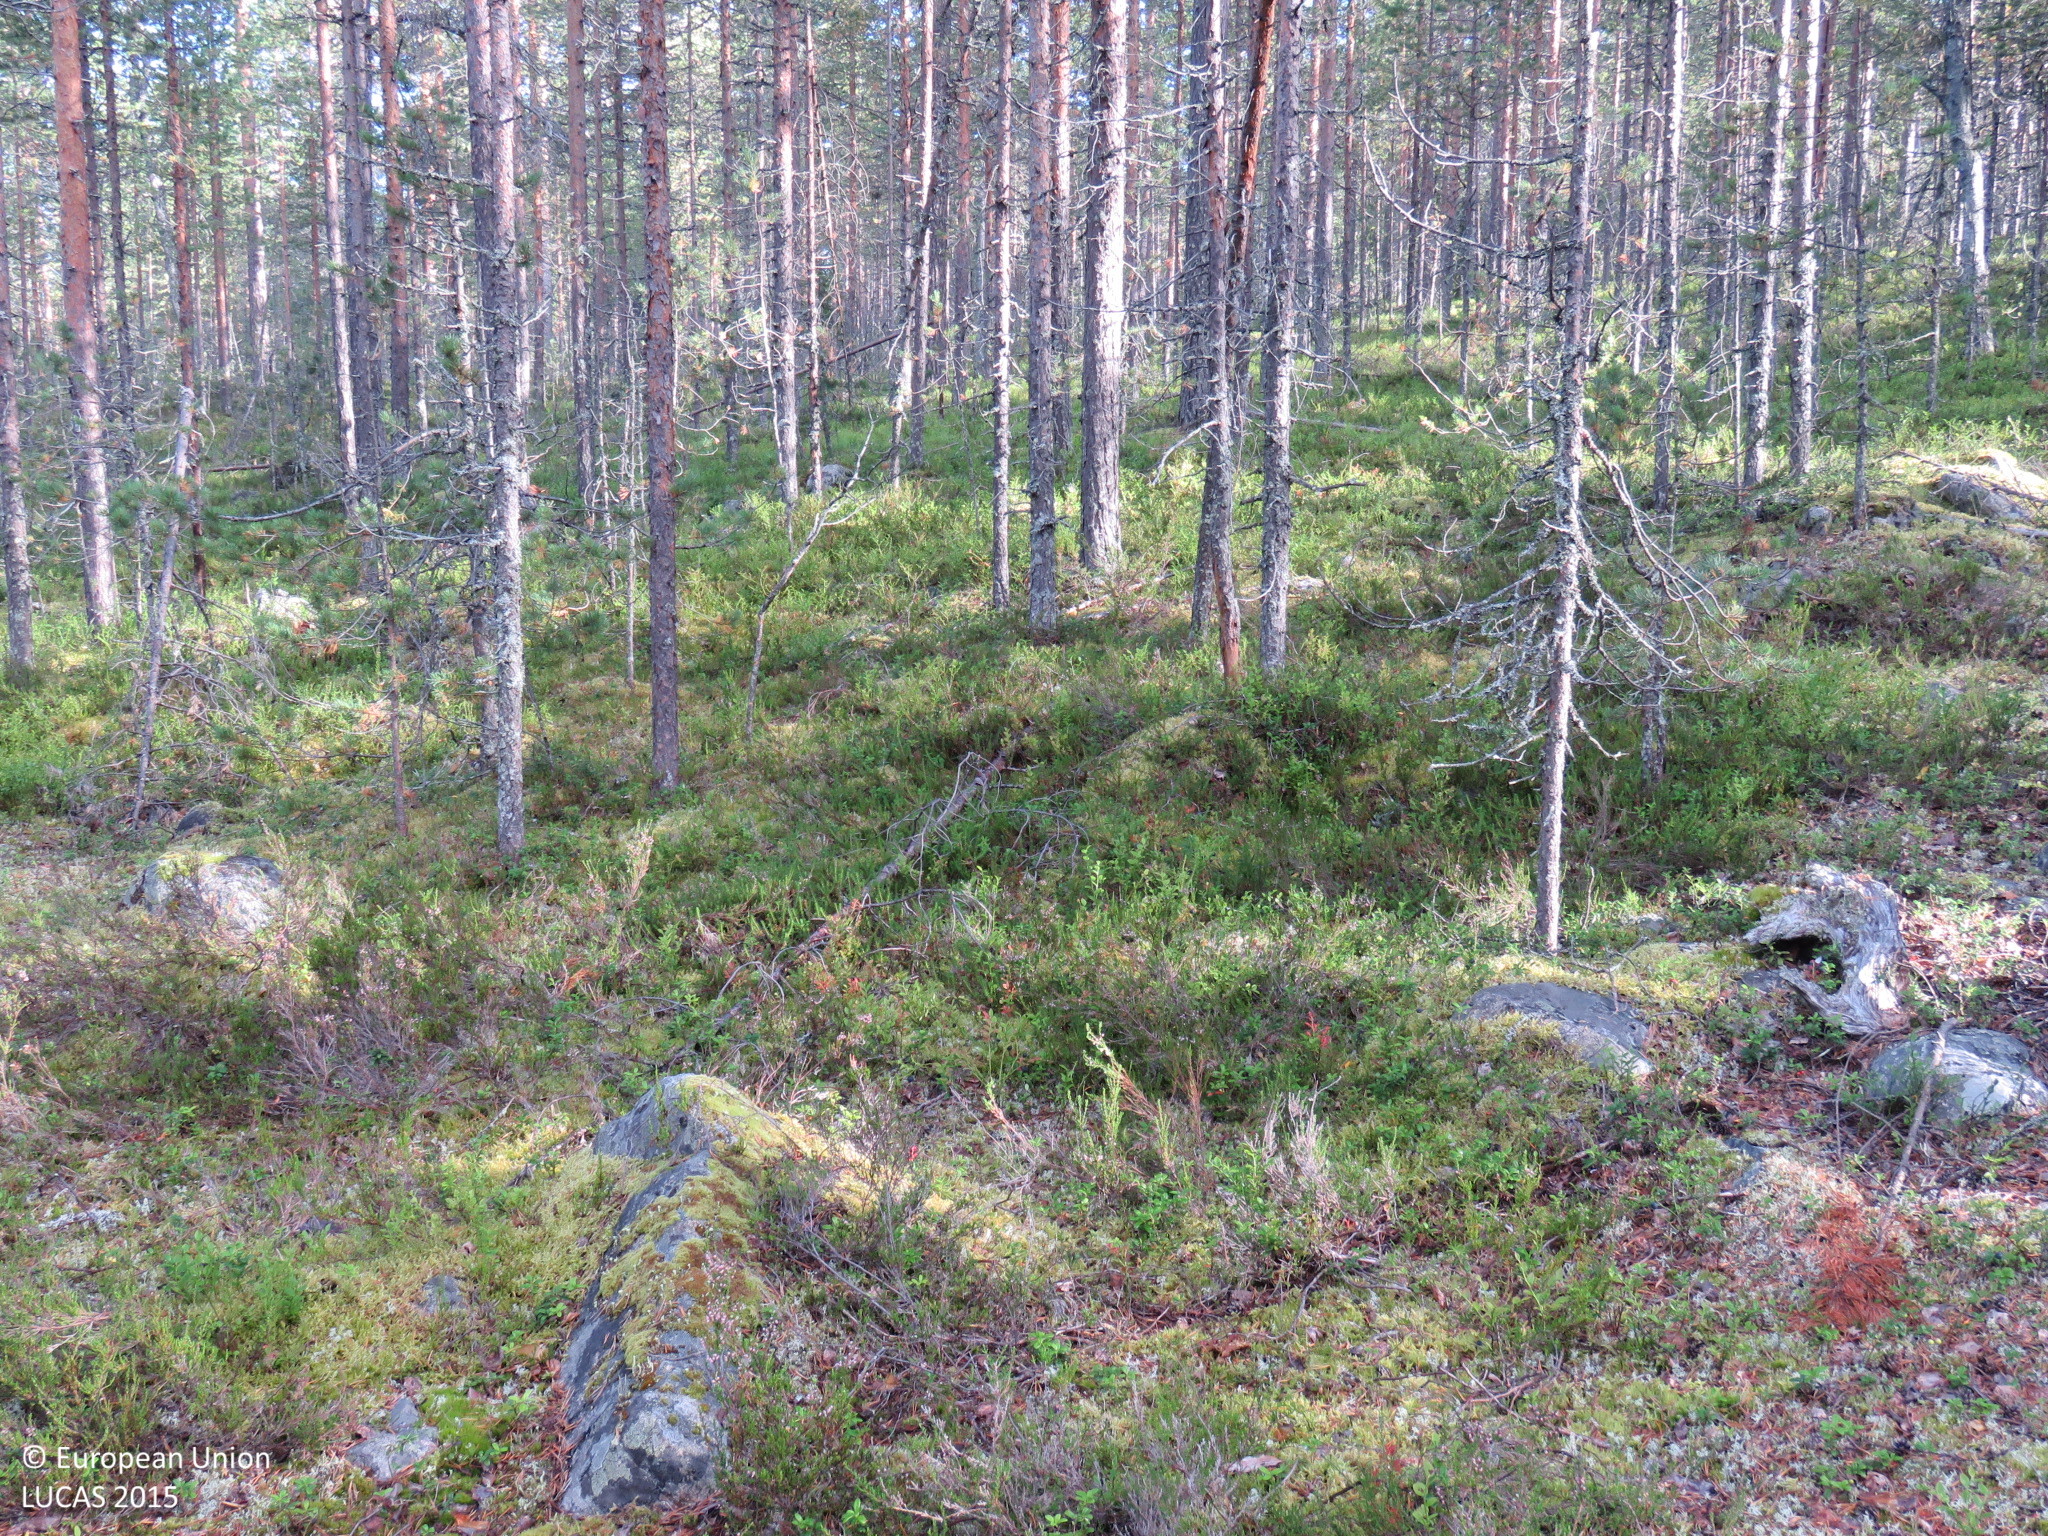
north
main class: Woodland
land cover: Pine dominated coniferous woodland
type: boreal forest
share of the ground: > 75 %
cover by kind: coniferous forest trees 75 %, shrubs 10 %, lichens and mosses 10 %, broadleaved forest trees 5 %
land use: Forestry
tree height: > 5 m
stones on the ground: < 10 %
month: September
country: FI
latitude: 65.3573
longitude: 27.4320
